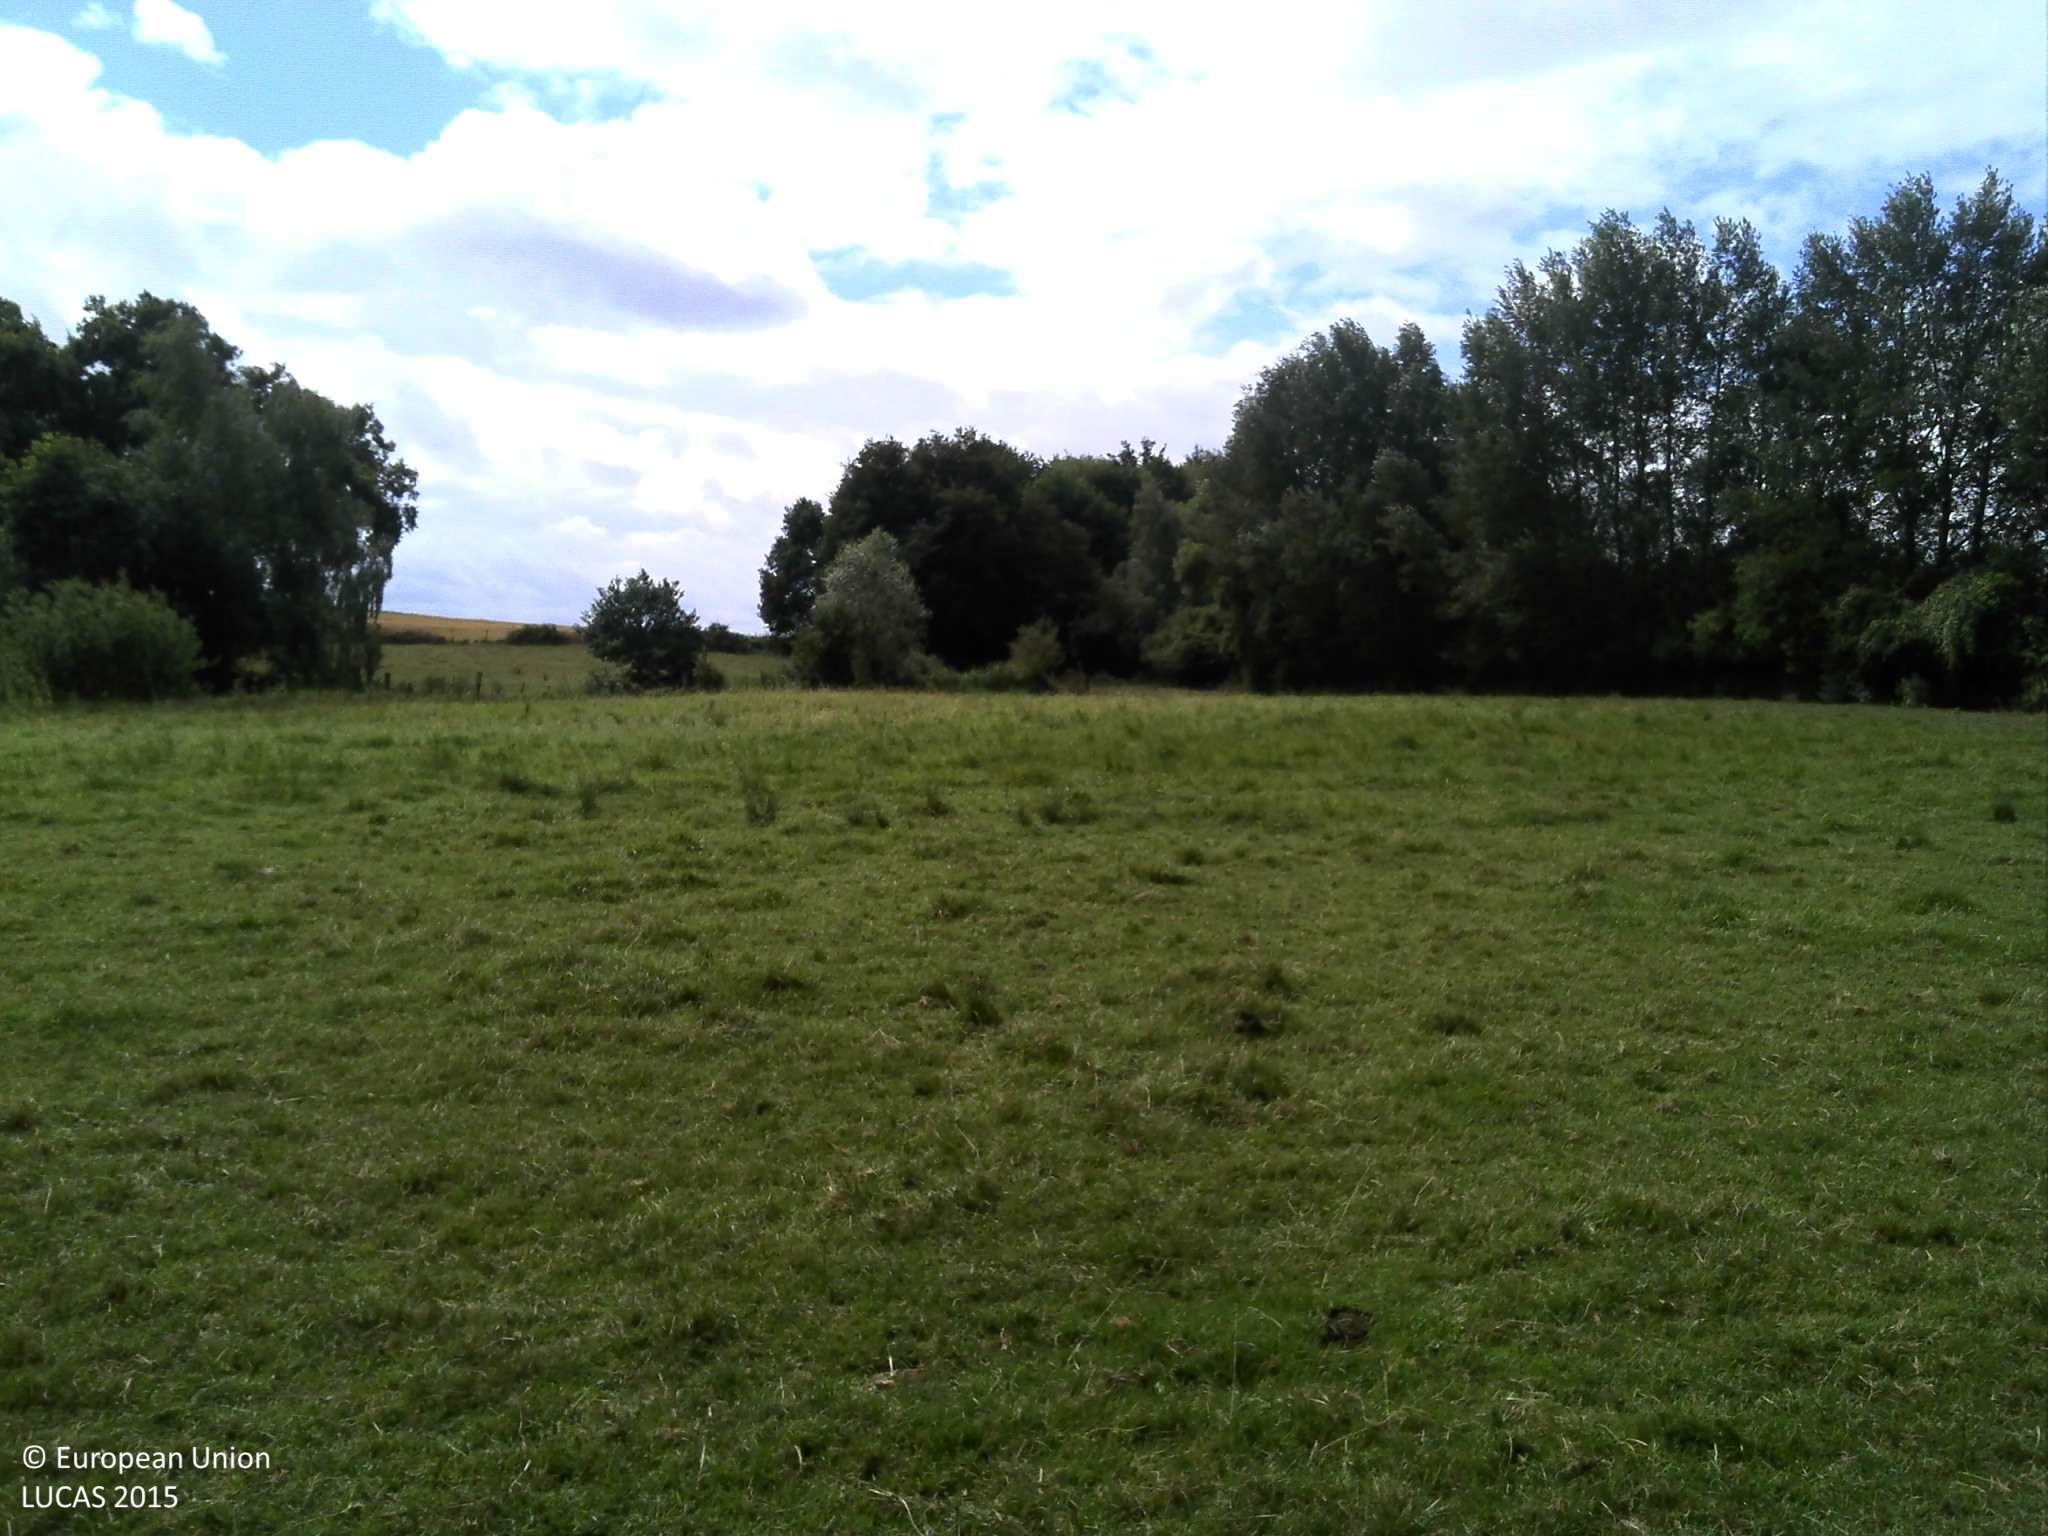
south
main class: Grassland
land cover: Grassland without tree/shrub cover
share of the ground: > 75 %
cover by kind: herbaceous plants 100 %
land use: Agriculture (excluding fallow land and kitchen gardens)
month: July
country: FR
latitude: 49.4104
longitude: 4.6628
